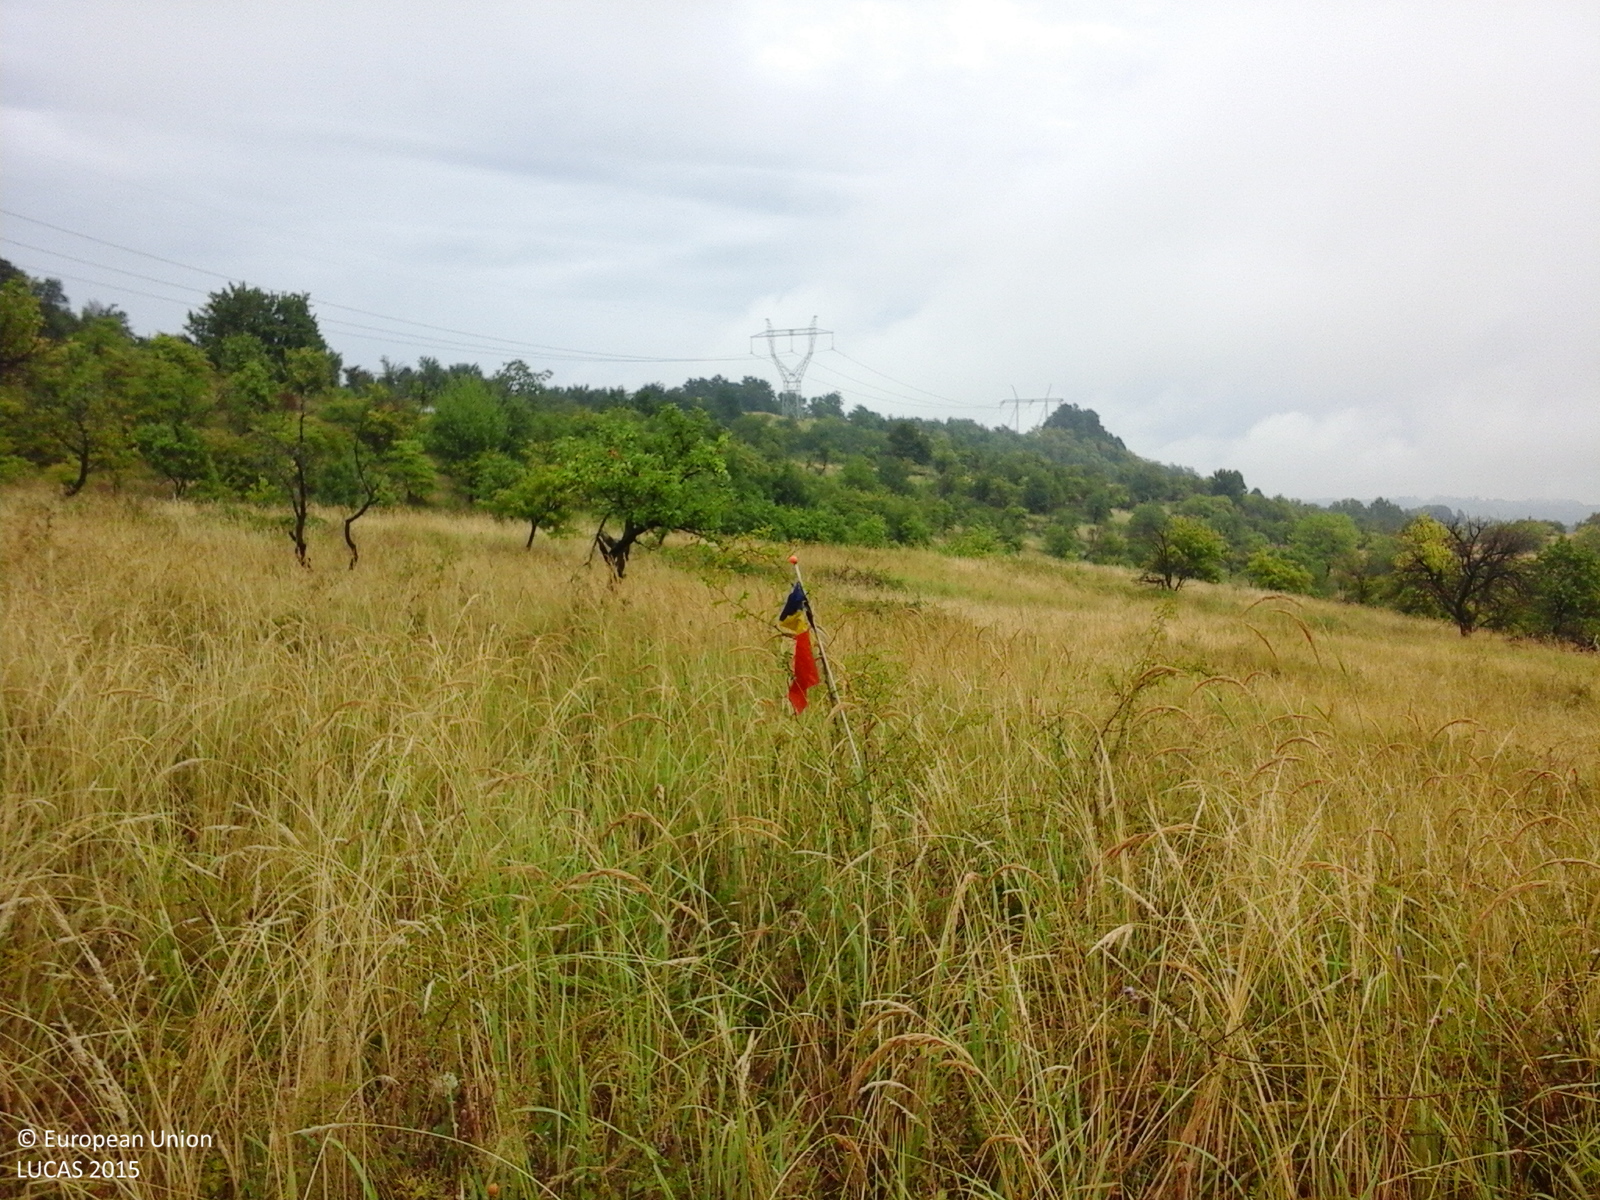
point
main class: Cropland
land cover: Apple fruit
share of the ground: > 75 %
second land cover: Spontaneously vegetated surfaces
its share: > 75 %
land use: Agriculture (excluding fallow land and kitchen gardens)
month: August
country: RO
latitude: 44.7800
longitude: 22.7703
